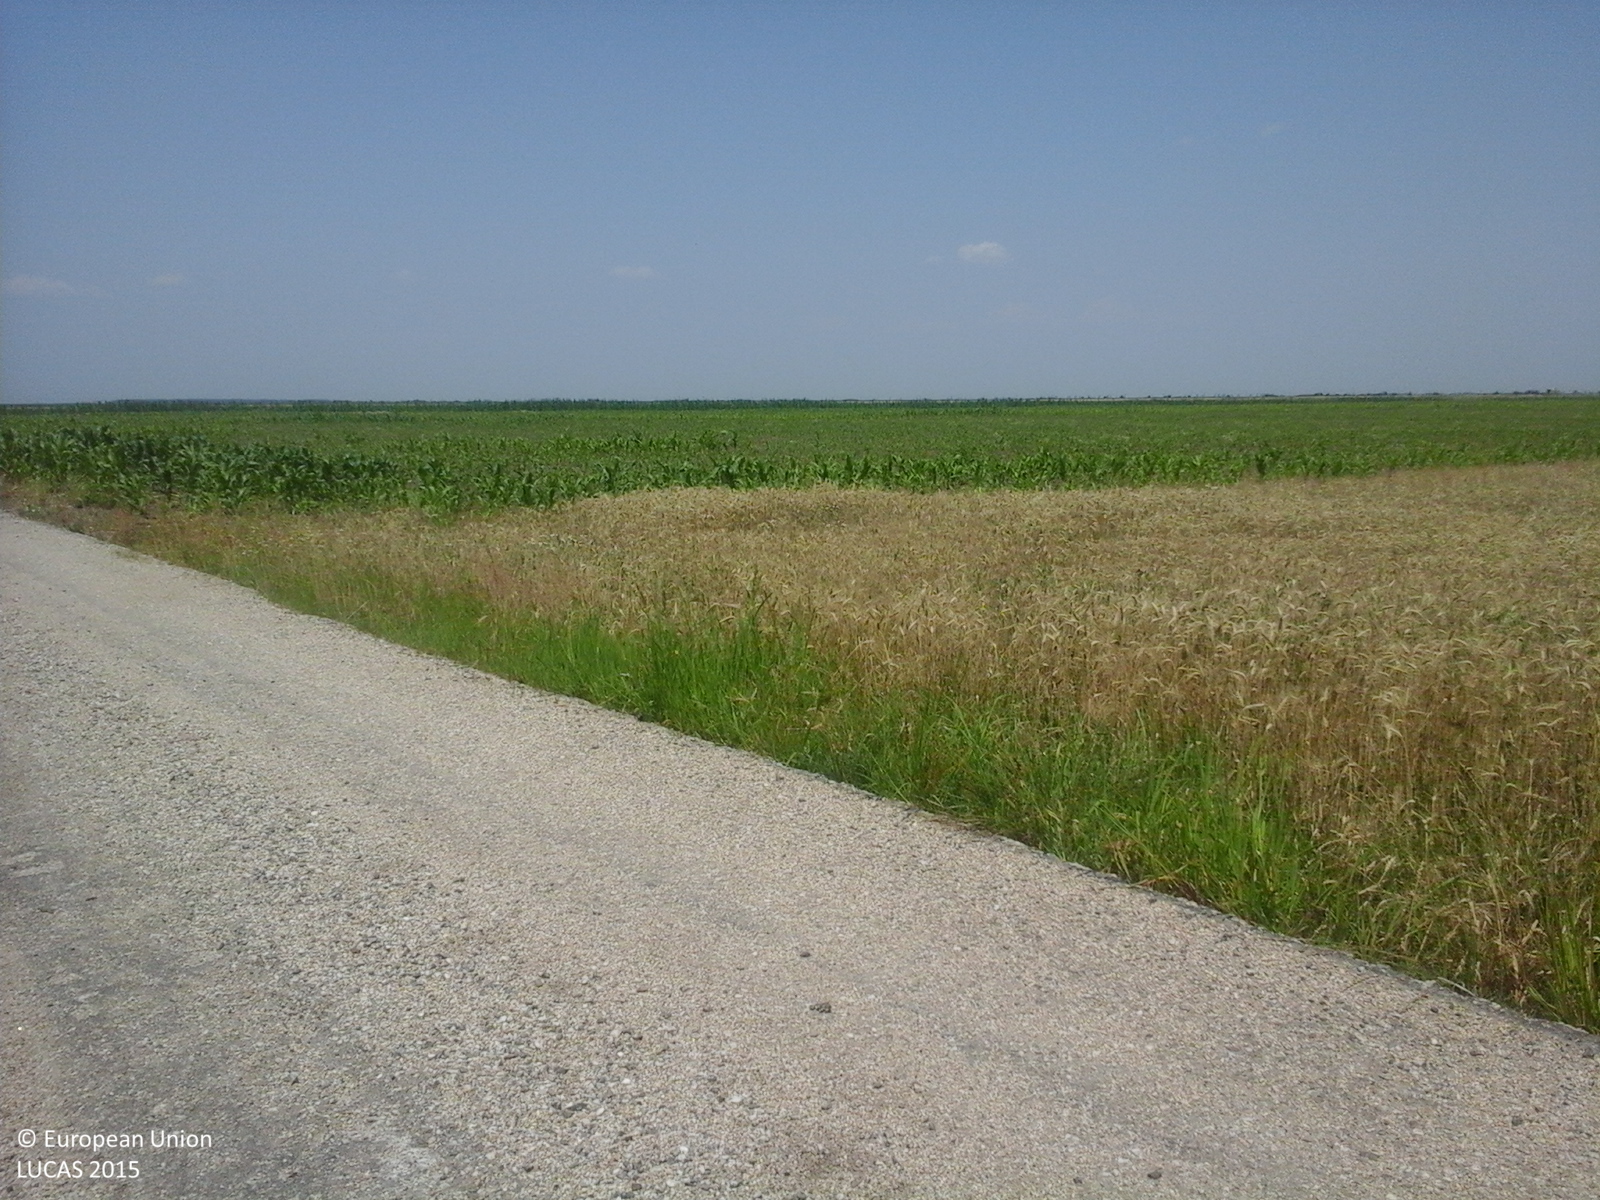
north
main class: Cropland
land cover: Sunflower
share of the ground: > 75 %
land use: Agriculture (excluding fallow land and kitchen gardens)
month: July
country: RO
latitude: 44.4975
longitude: 24.8811
